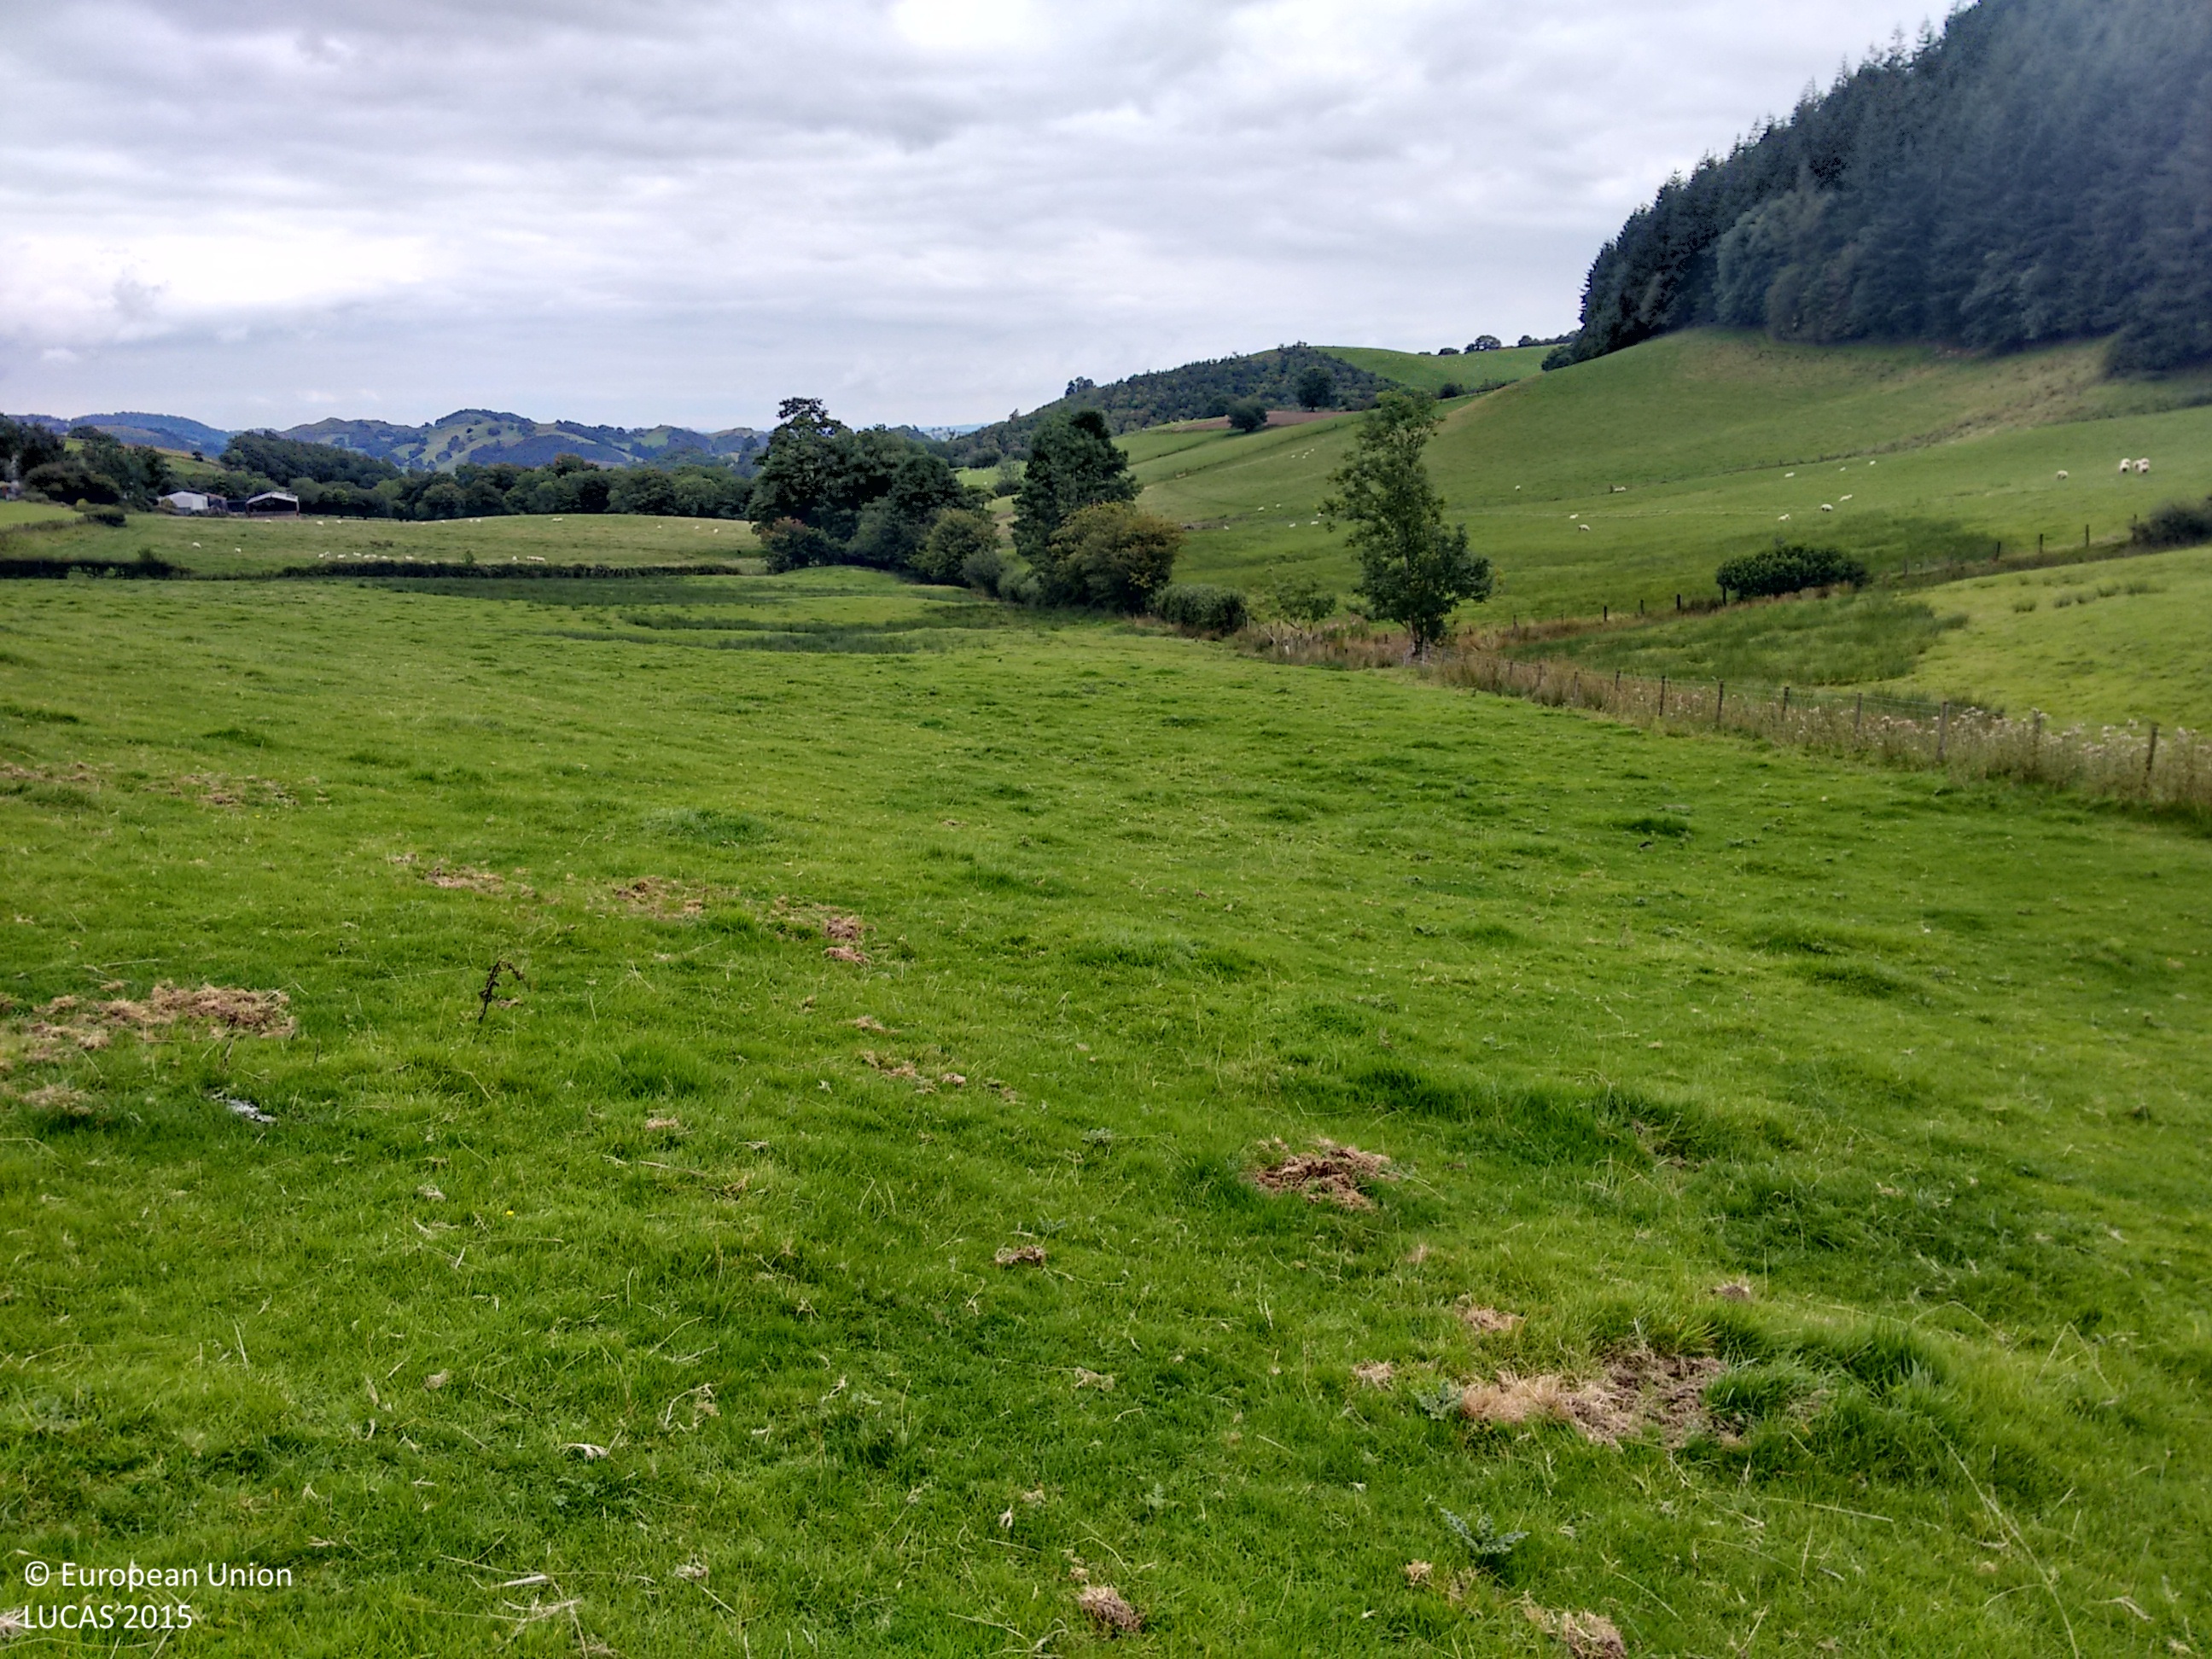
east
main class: Grassland
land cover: Grassland without tree/shrub cover
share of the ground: > 75 %
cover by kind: herbaceous plants 100 %
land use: Agriculture (excluding fallow land and kitchen gardens)
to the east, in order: Grassland without tree/shrub cover; Ditches and canals; Managed hedges; Fences; Grassland without tree/shrub cover; Fences; Grassland without tree/shrub cover
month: September
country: GB
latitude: 52.7538
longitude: -3.3116
